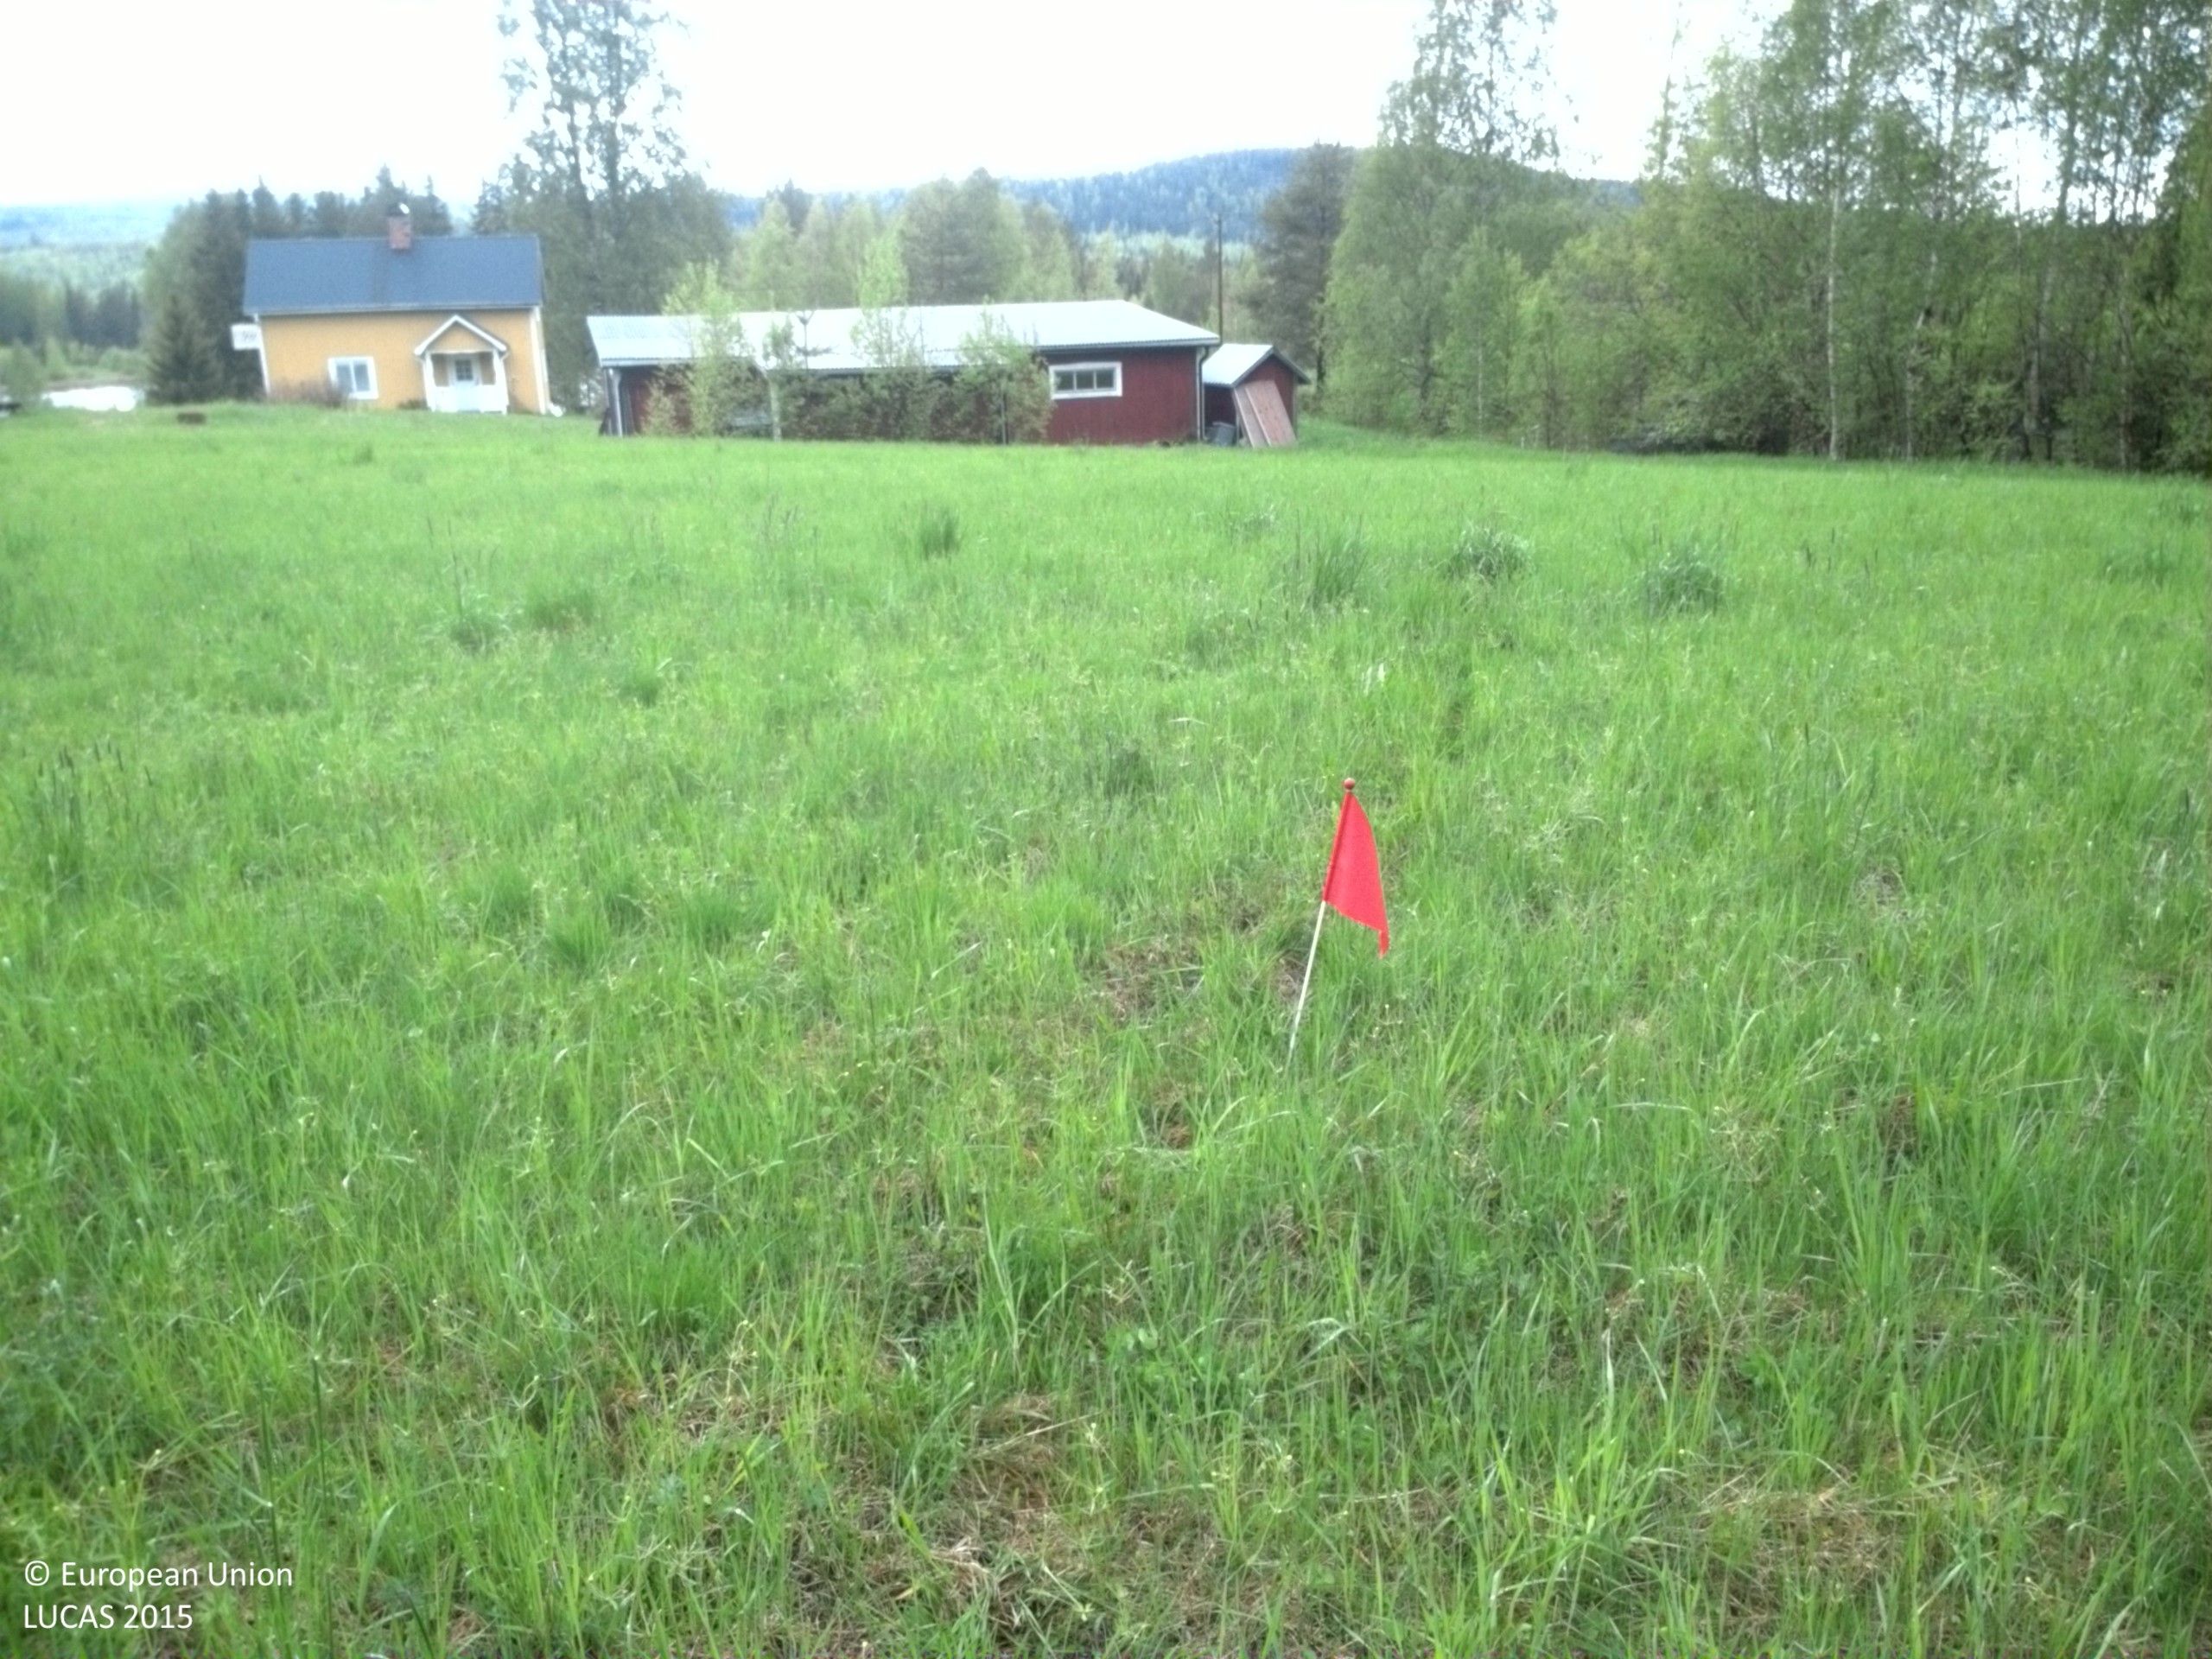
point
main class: Cropland
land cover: Temporary grasslands
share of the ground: > 75 %
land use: Agriculture (excluding fallow land and kitchen gardens)
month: June
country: SE
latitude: 63.2106
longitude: 16.9955
